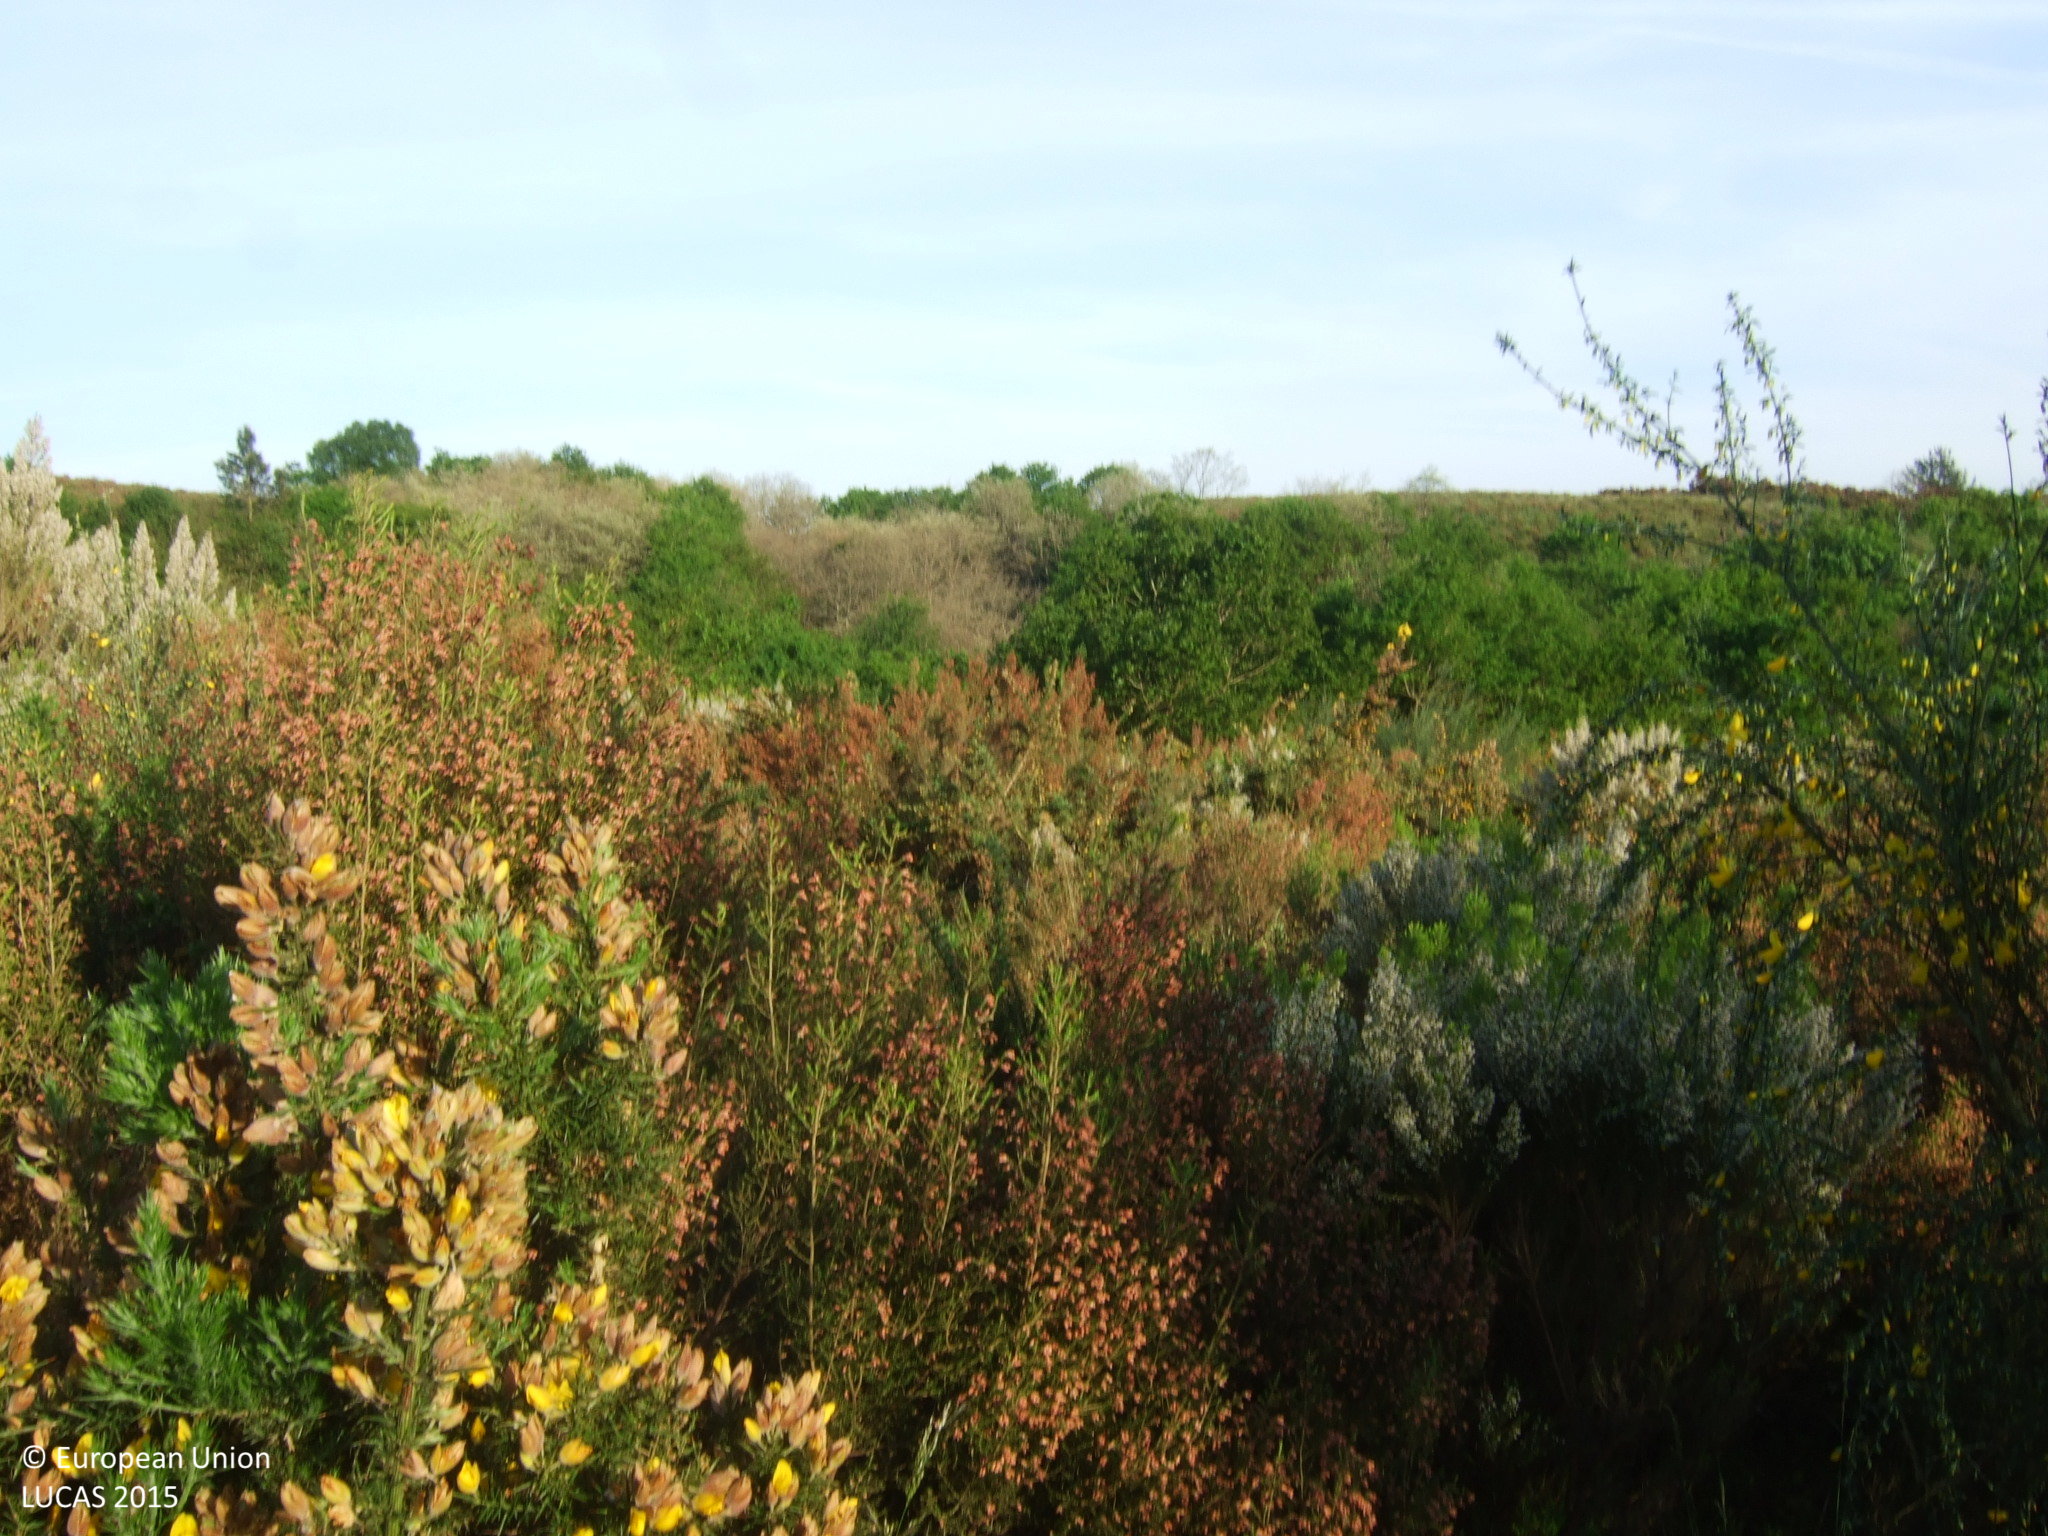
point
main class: Shrubland
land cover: Shrubland without tree cover
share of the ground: > 75 %
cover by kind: shrubs 100 %
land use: Abandoned areas
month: May
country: ES
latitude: 43.0432
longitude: -7.4441
